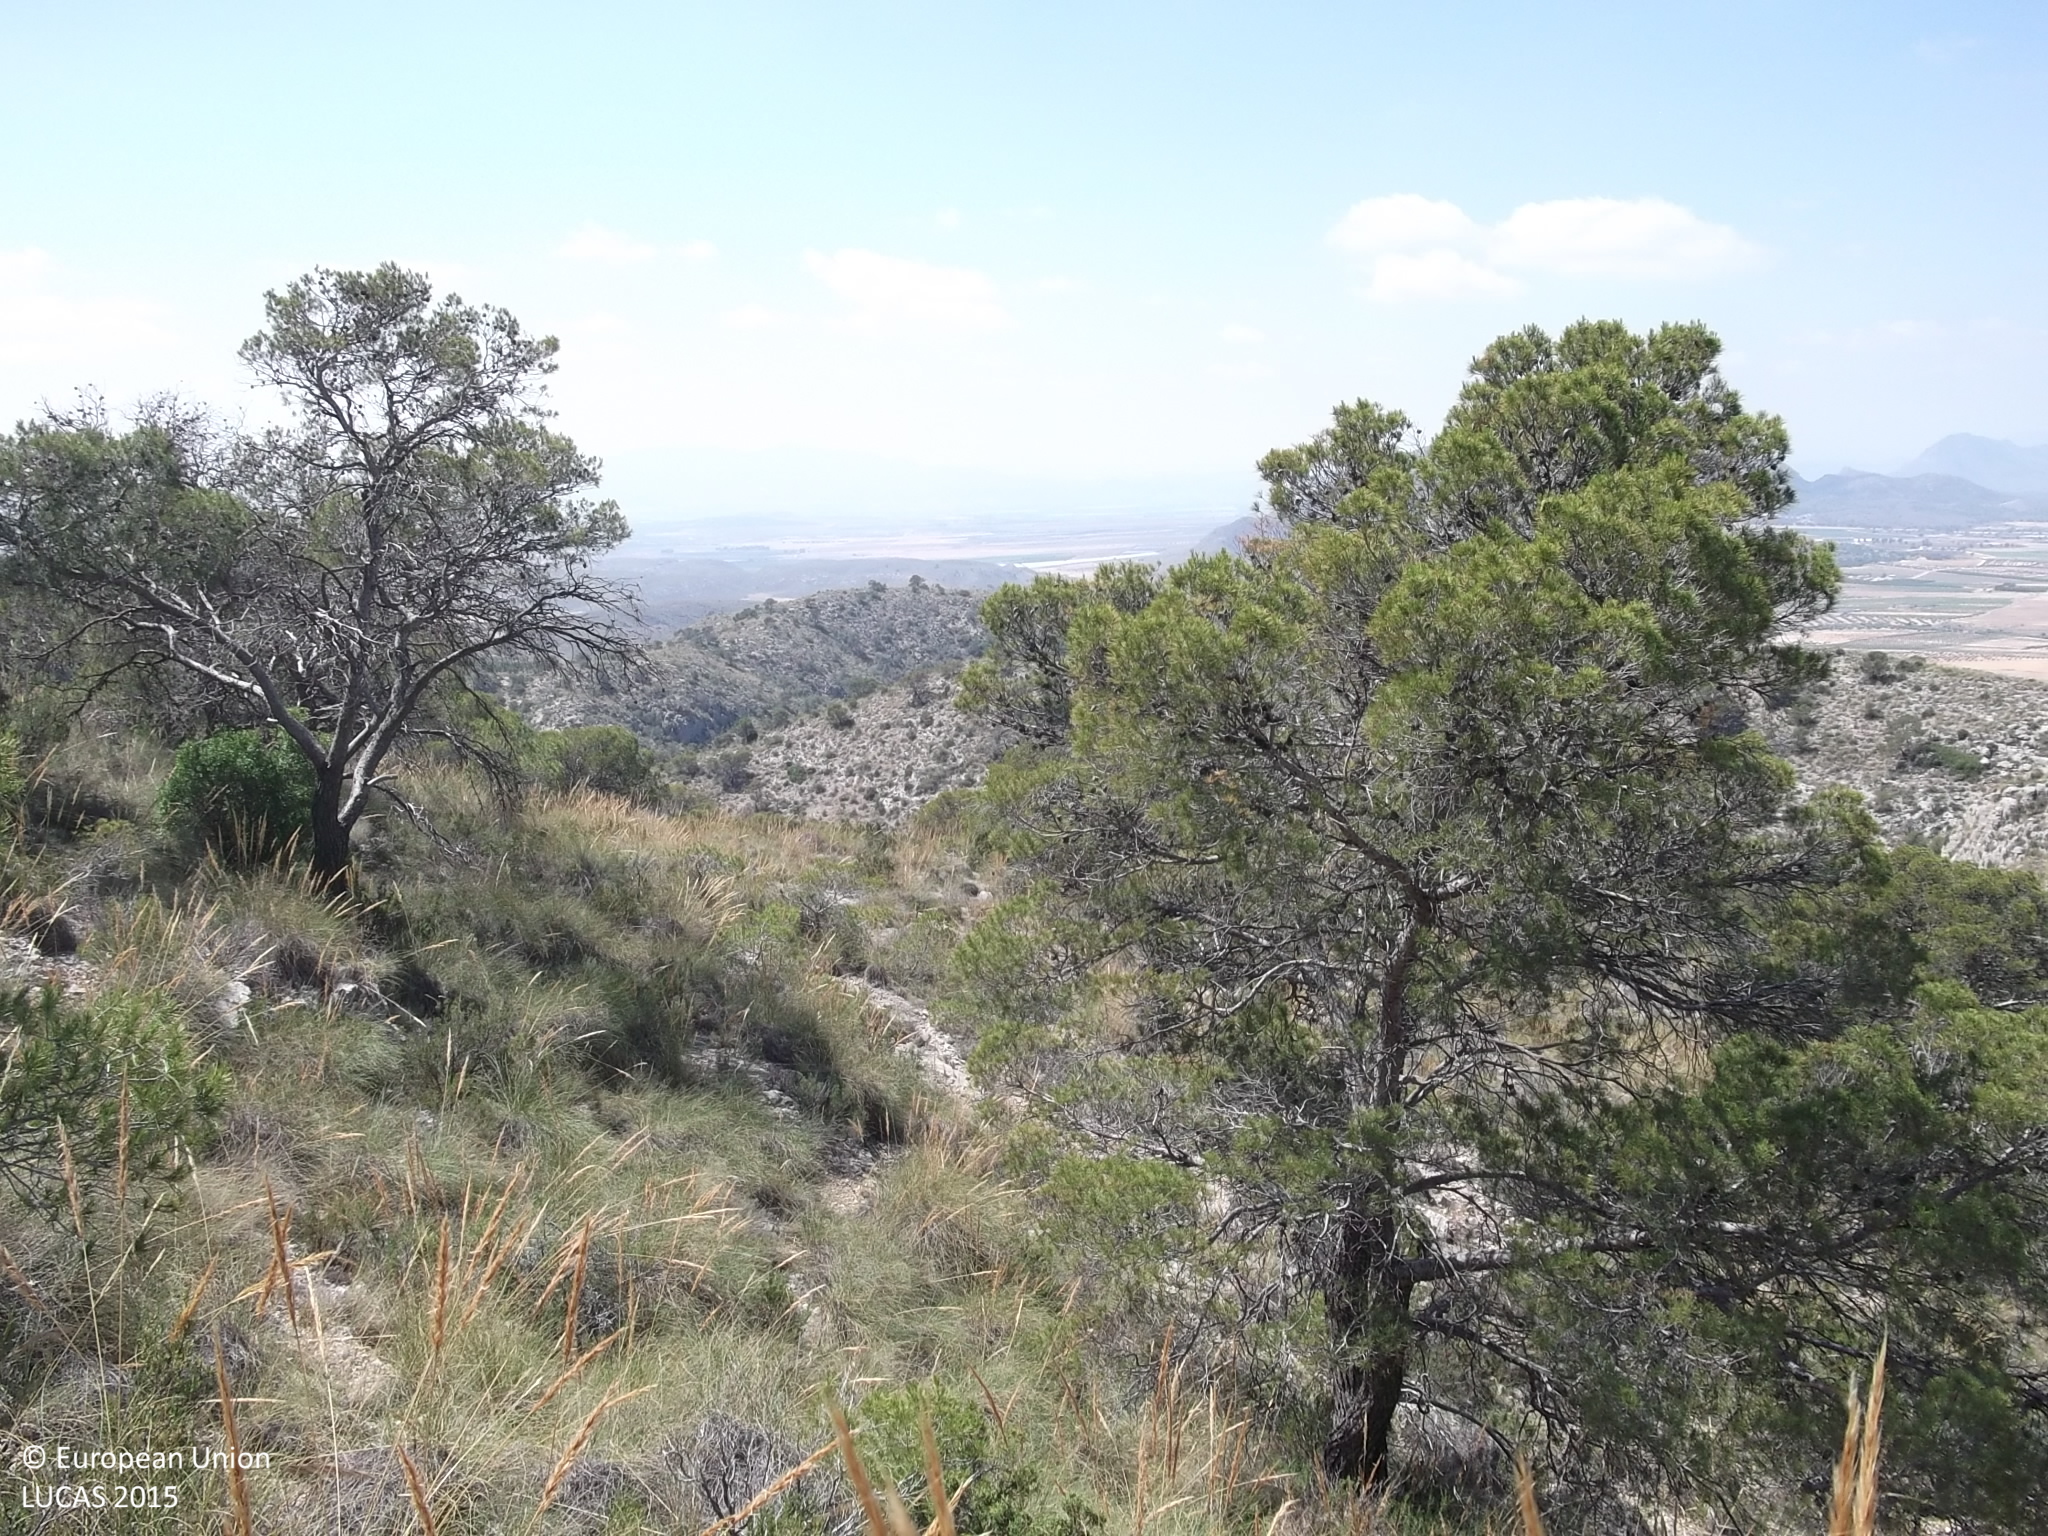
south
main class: Woodland
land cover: Pine dominated coniferous woodland
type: coniferous forest of the mediterranean region
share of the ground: 10 - 25 %
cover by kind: shrubs 30 %, consolidated bare surface 30 %, coniferous forest trees 20 %, herbaceous plants 20 %
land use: Semi-natural and natural areas not in use
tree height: > 5 m
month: May
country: ES
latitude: 38.4452
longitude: -1.4372
